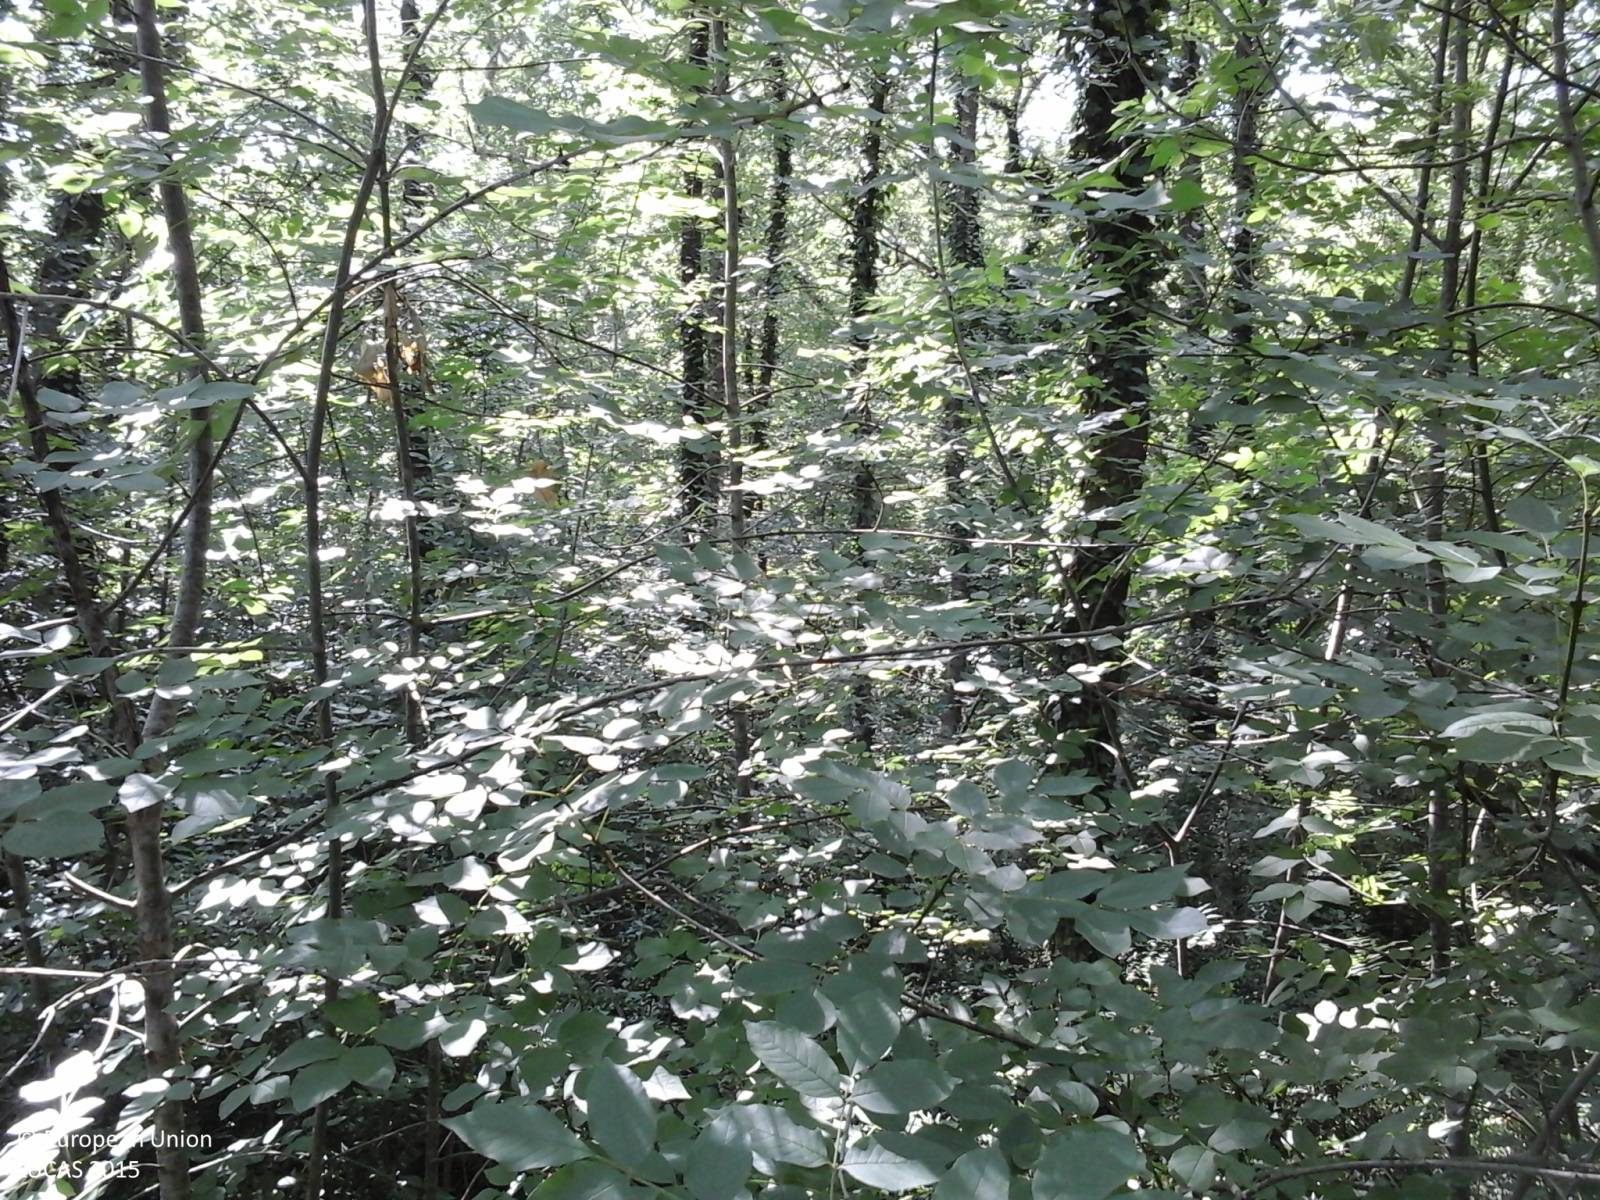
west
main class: Woodland
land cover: Broadleaved woodland
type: thermophilous deciduous forest
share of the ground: > 75 %
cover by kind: broadleaved forest trees 100 %
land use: Forestry
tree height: > 5 m
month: June
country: IT
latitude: 43.9141
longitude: 10.8571
